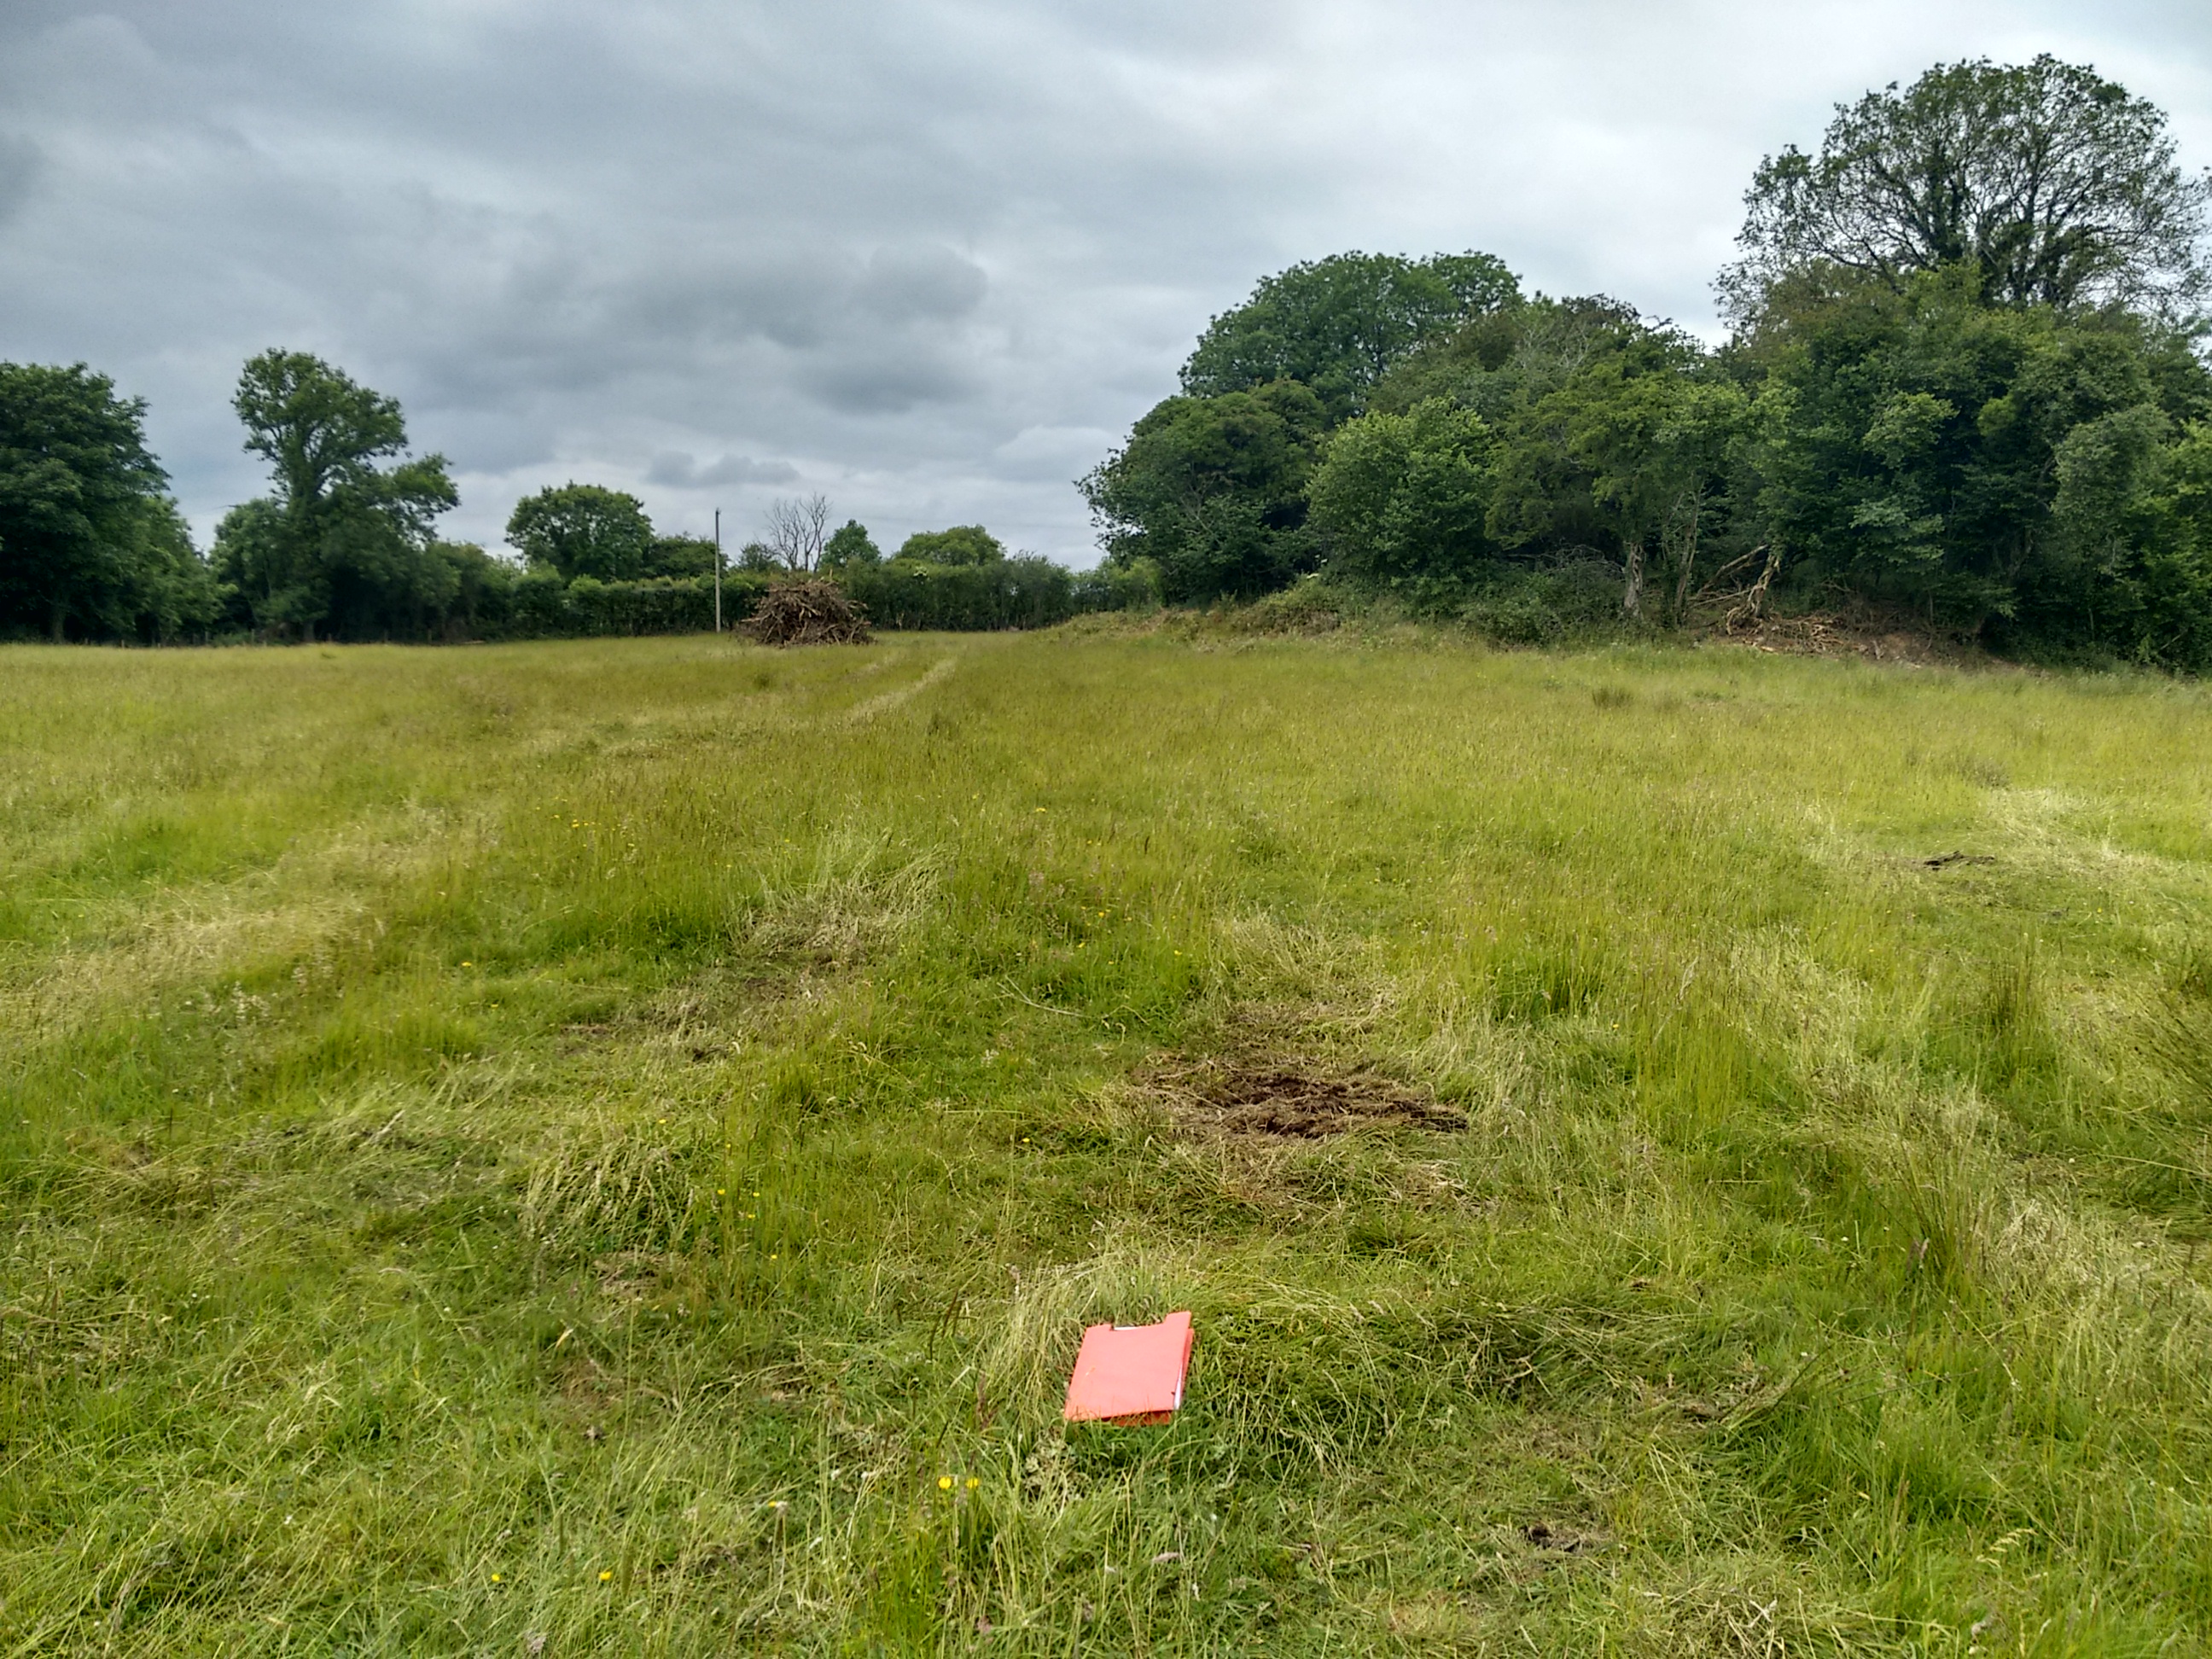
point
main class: Grassland
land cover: Grassland without tree/shrub cover
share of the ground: > 75 %
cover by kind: herbaceous plants 95 %, shrubs 5 %
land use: Agriculture (excluding fallow land and kitchen gardens)
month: June
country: IE
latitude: 53.3983
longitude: -7.7788
